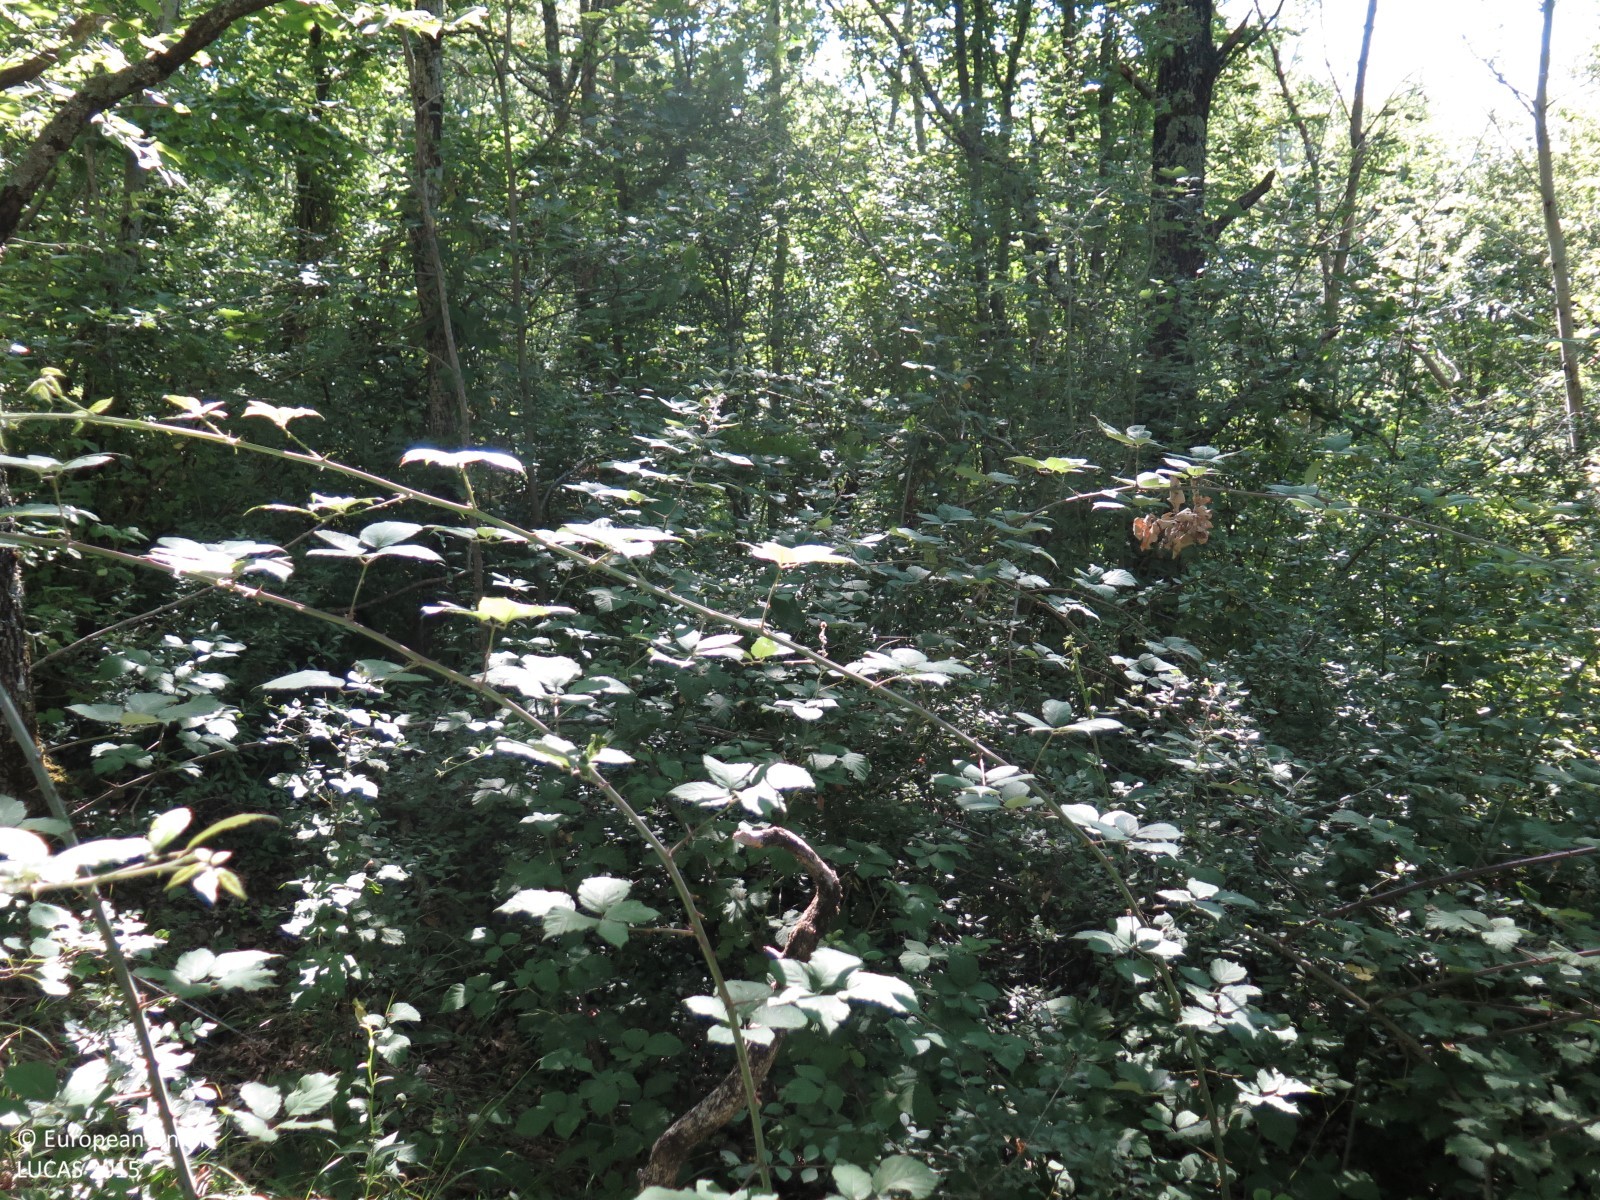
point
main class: Woodland
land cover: Broadleaved woodland
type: mesophytic deciduous forest
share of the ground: > 75 %
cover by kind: broadleaved forest trees 95 %, herbaceous plants 5 %
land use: Semi-natural and natural areas not in use
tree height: > 5 m
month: July
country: HR
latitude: 45.2707
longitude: 13.8824
